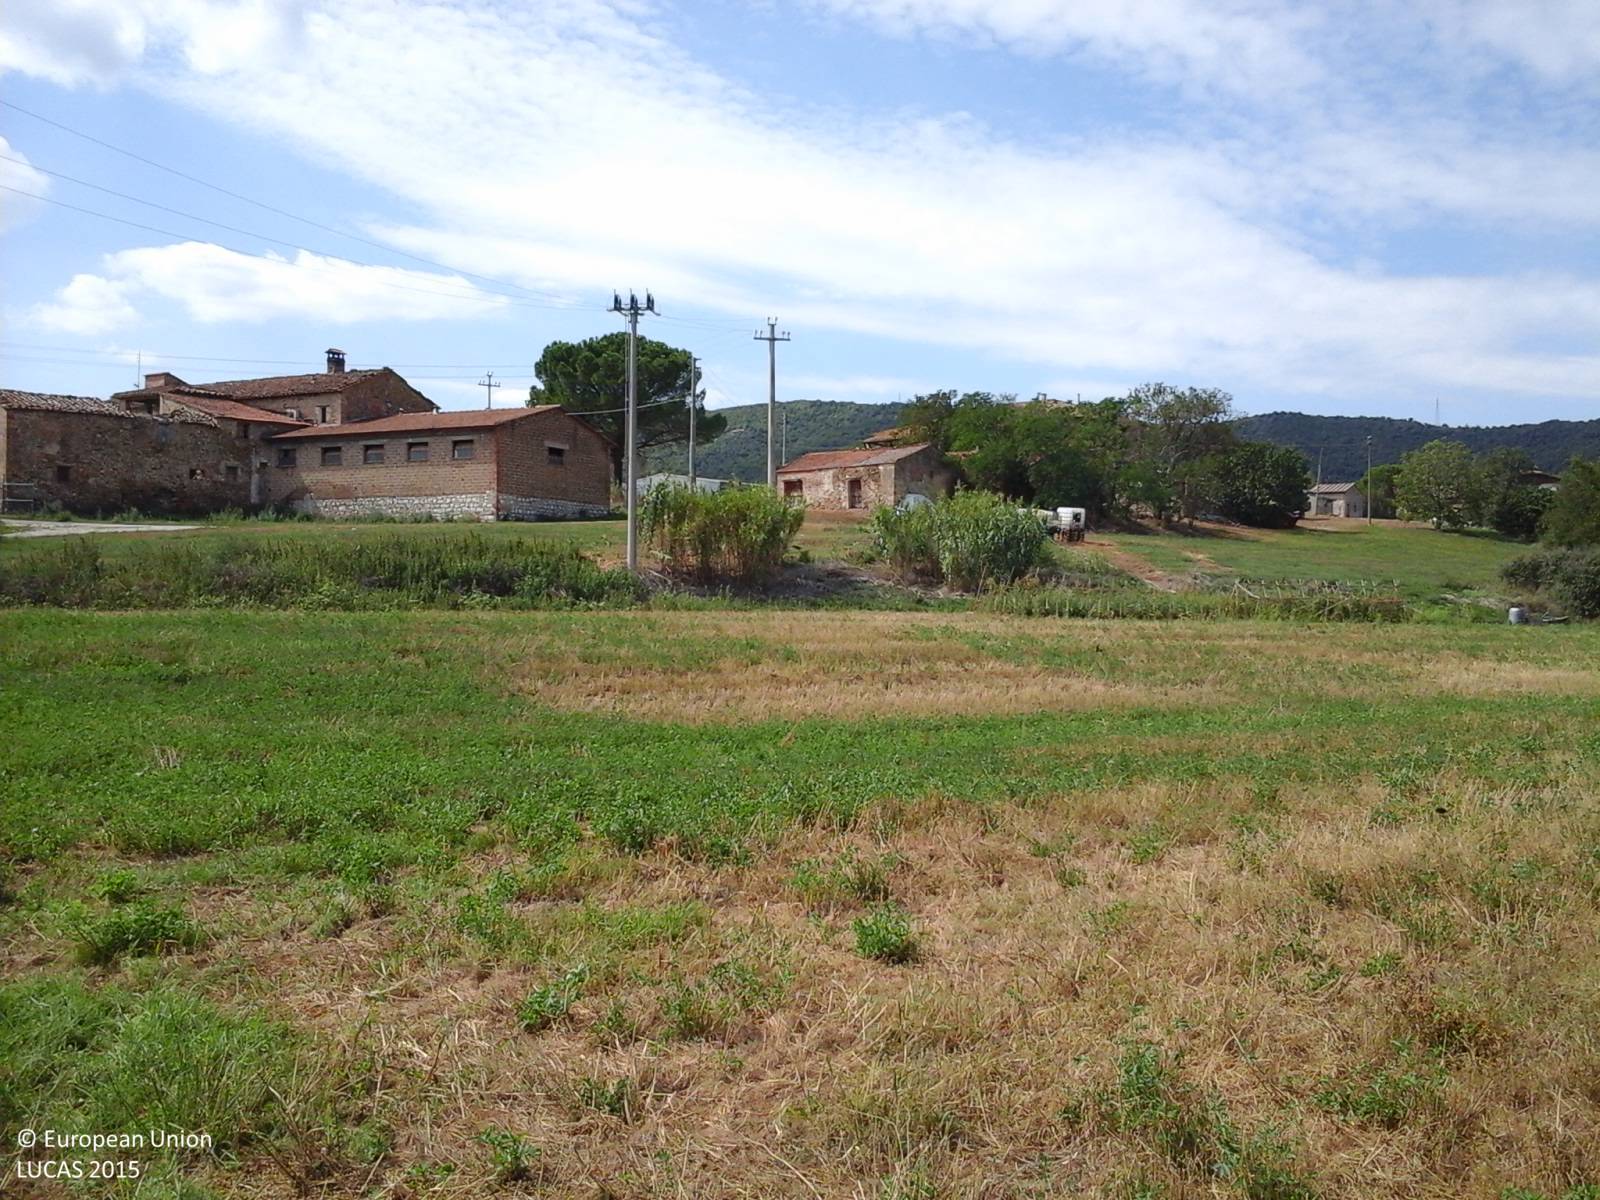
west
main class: Grassland
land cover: Grassland without tree/shrub cover
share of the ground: 50 - 75 %
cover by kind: herbaceous plants 100 %
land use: Agriculture (excluding fallow land and kitchen gardens)
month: September
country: IT
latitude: 43.0989
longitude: 12.2419
